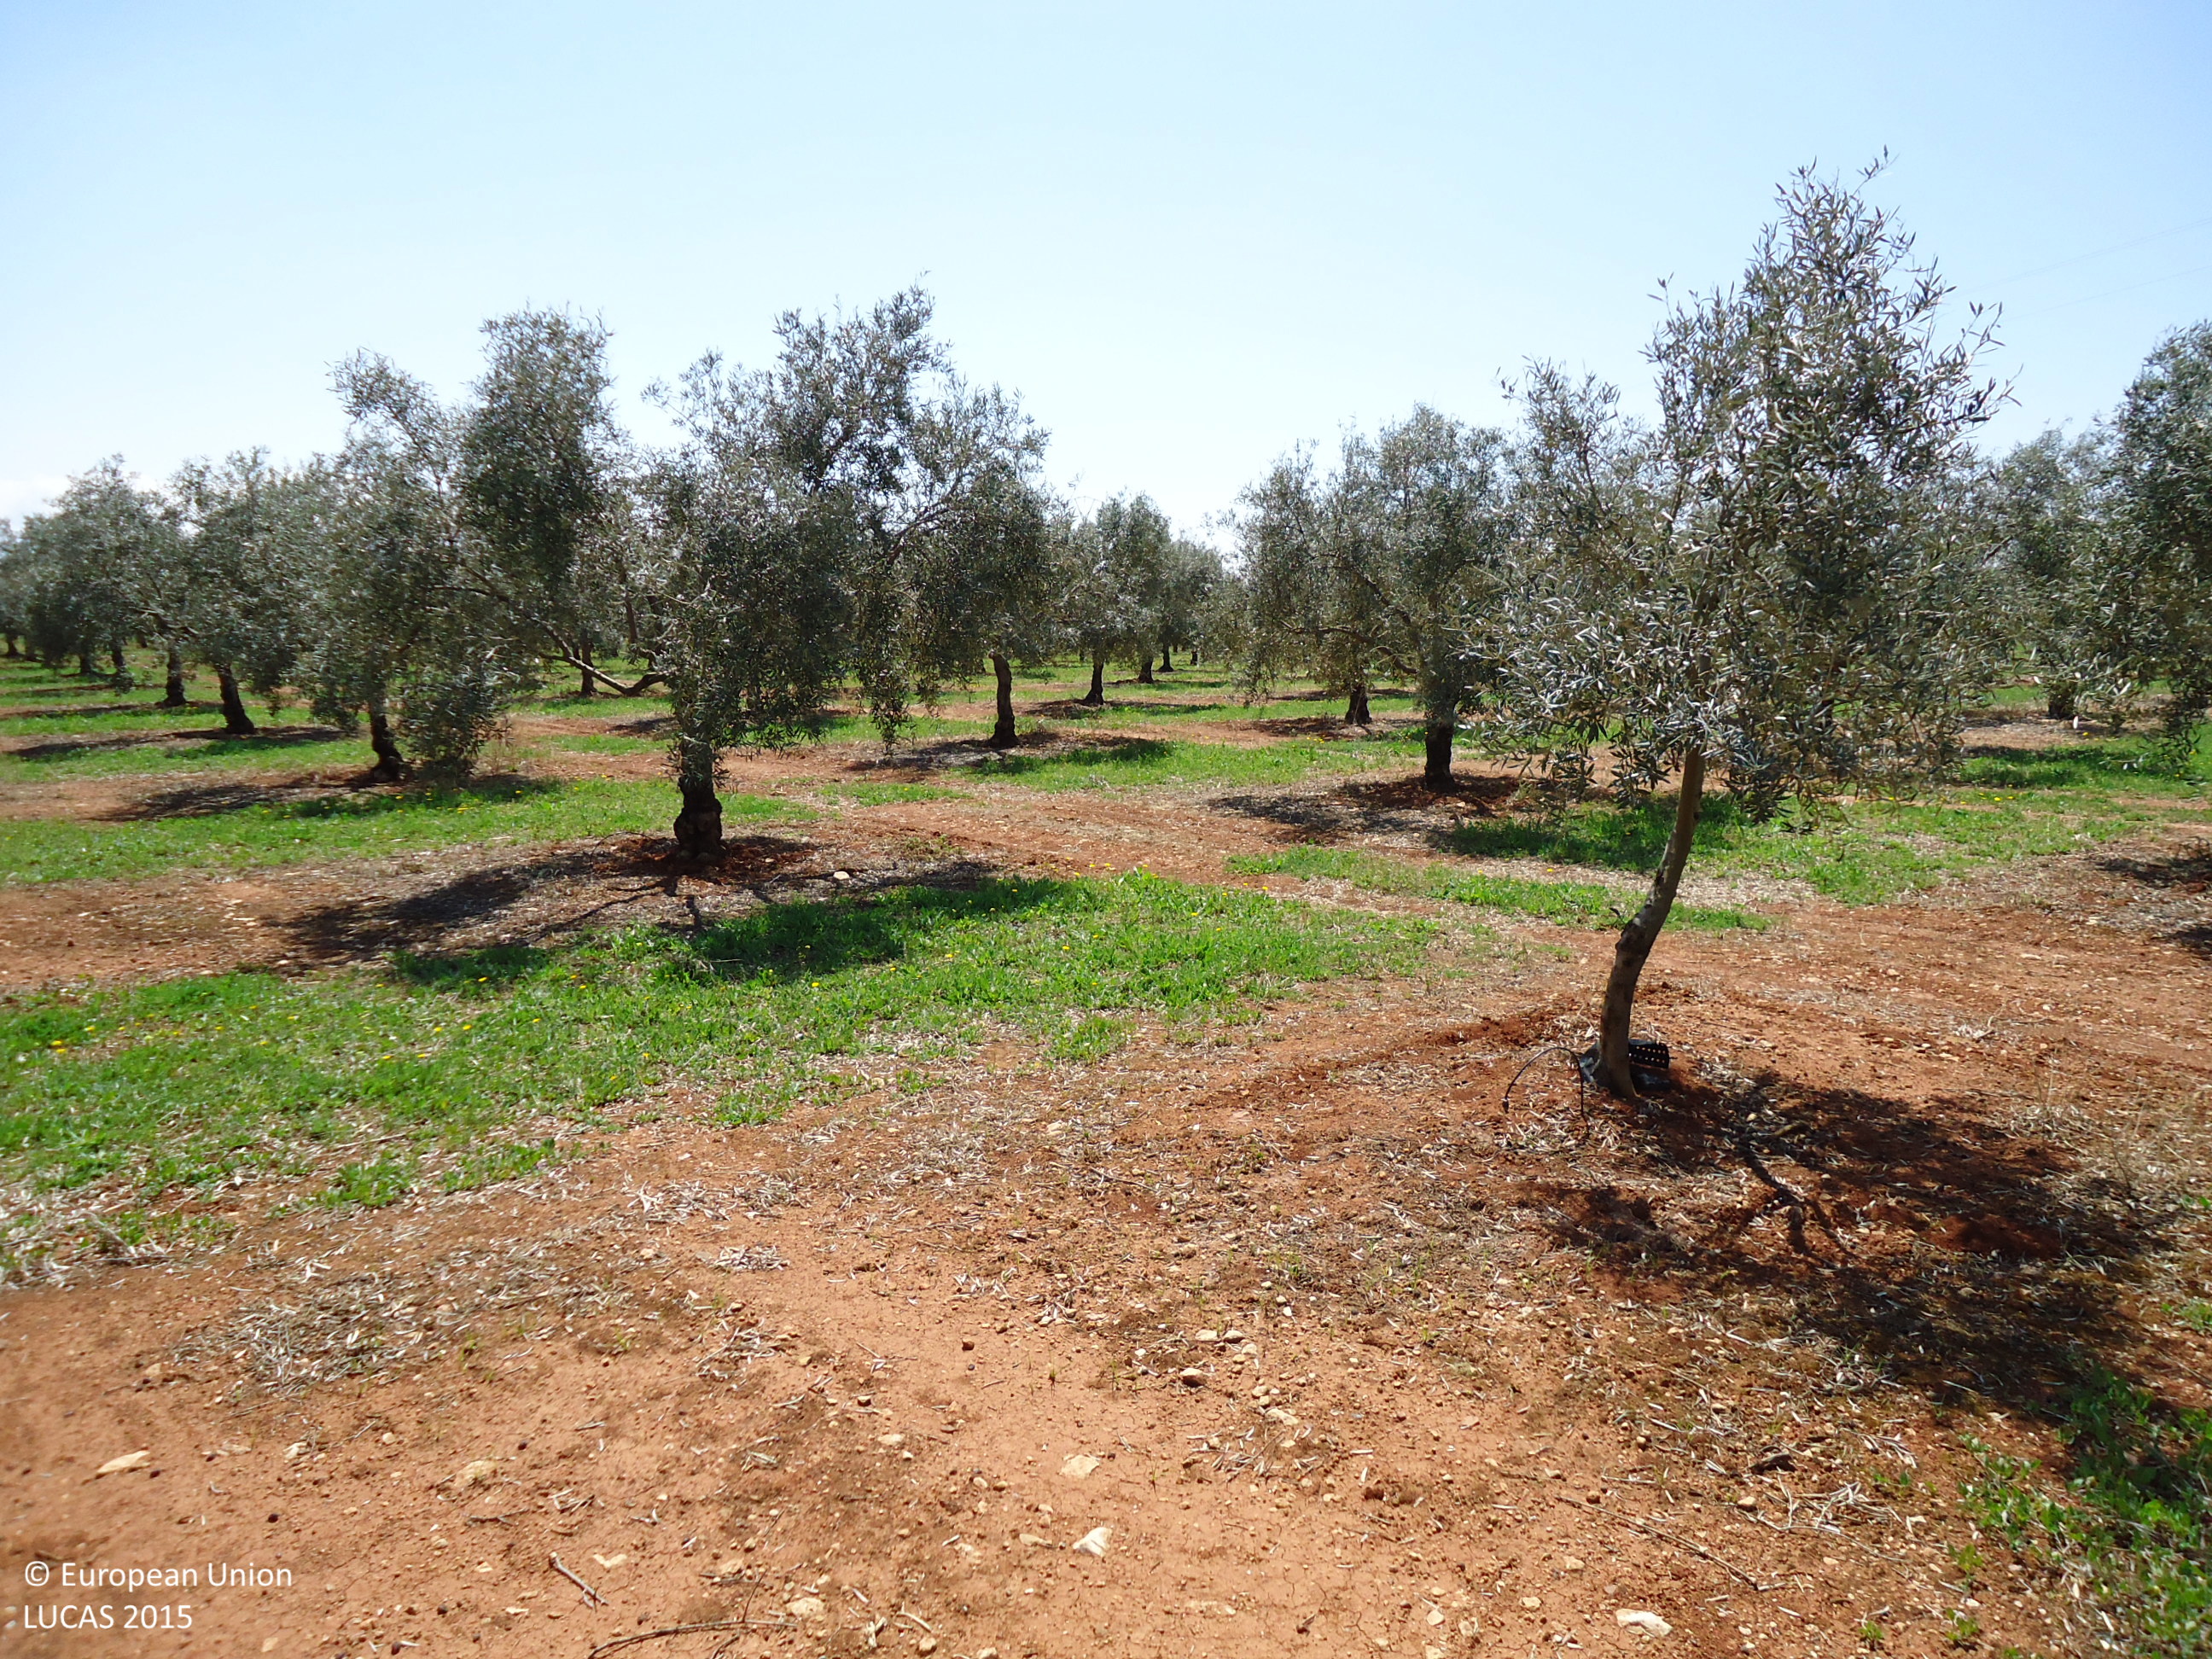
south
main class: Cropland
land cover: Olive groves
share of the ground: 25 - 50 %
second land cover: Spontaneously vegetated surfaces
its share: 50 - 75 %
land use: Agriculture (excluding fallow land and kitchen gardens)
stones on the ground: < 10 %
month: April
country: ES
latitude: 37.0735
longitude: -4.8370
